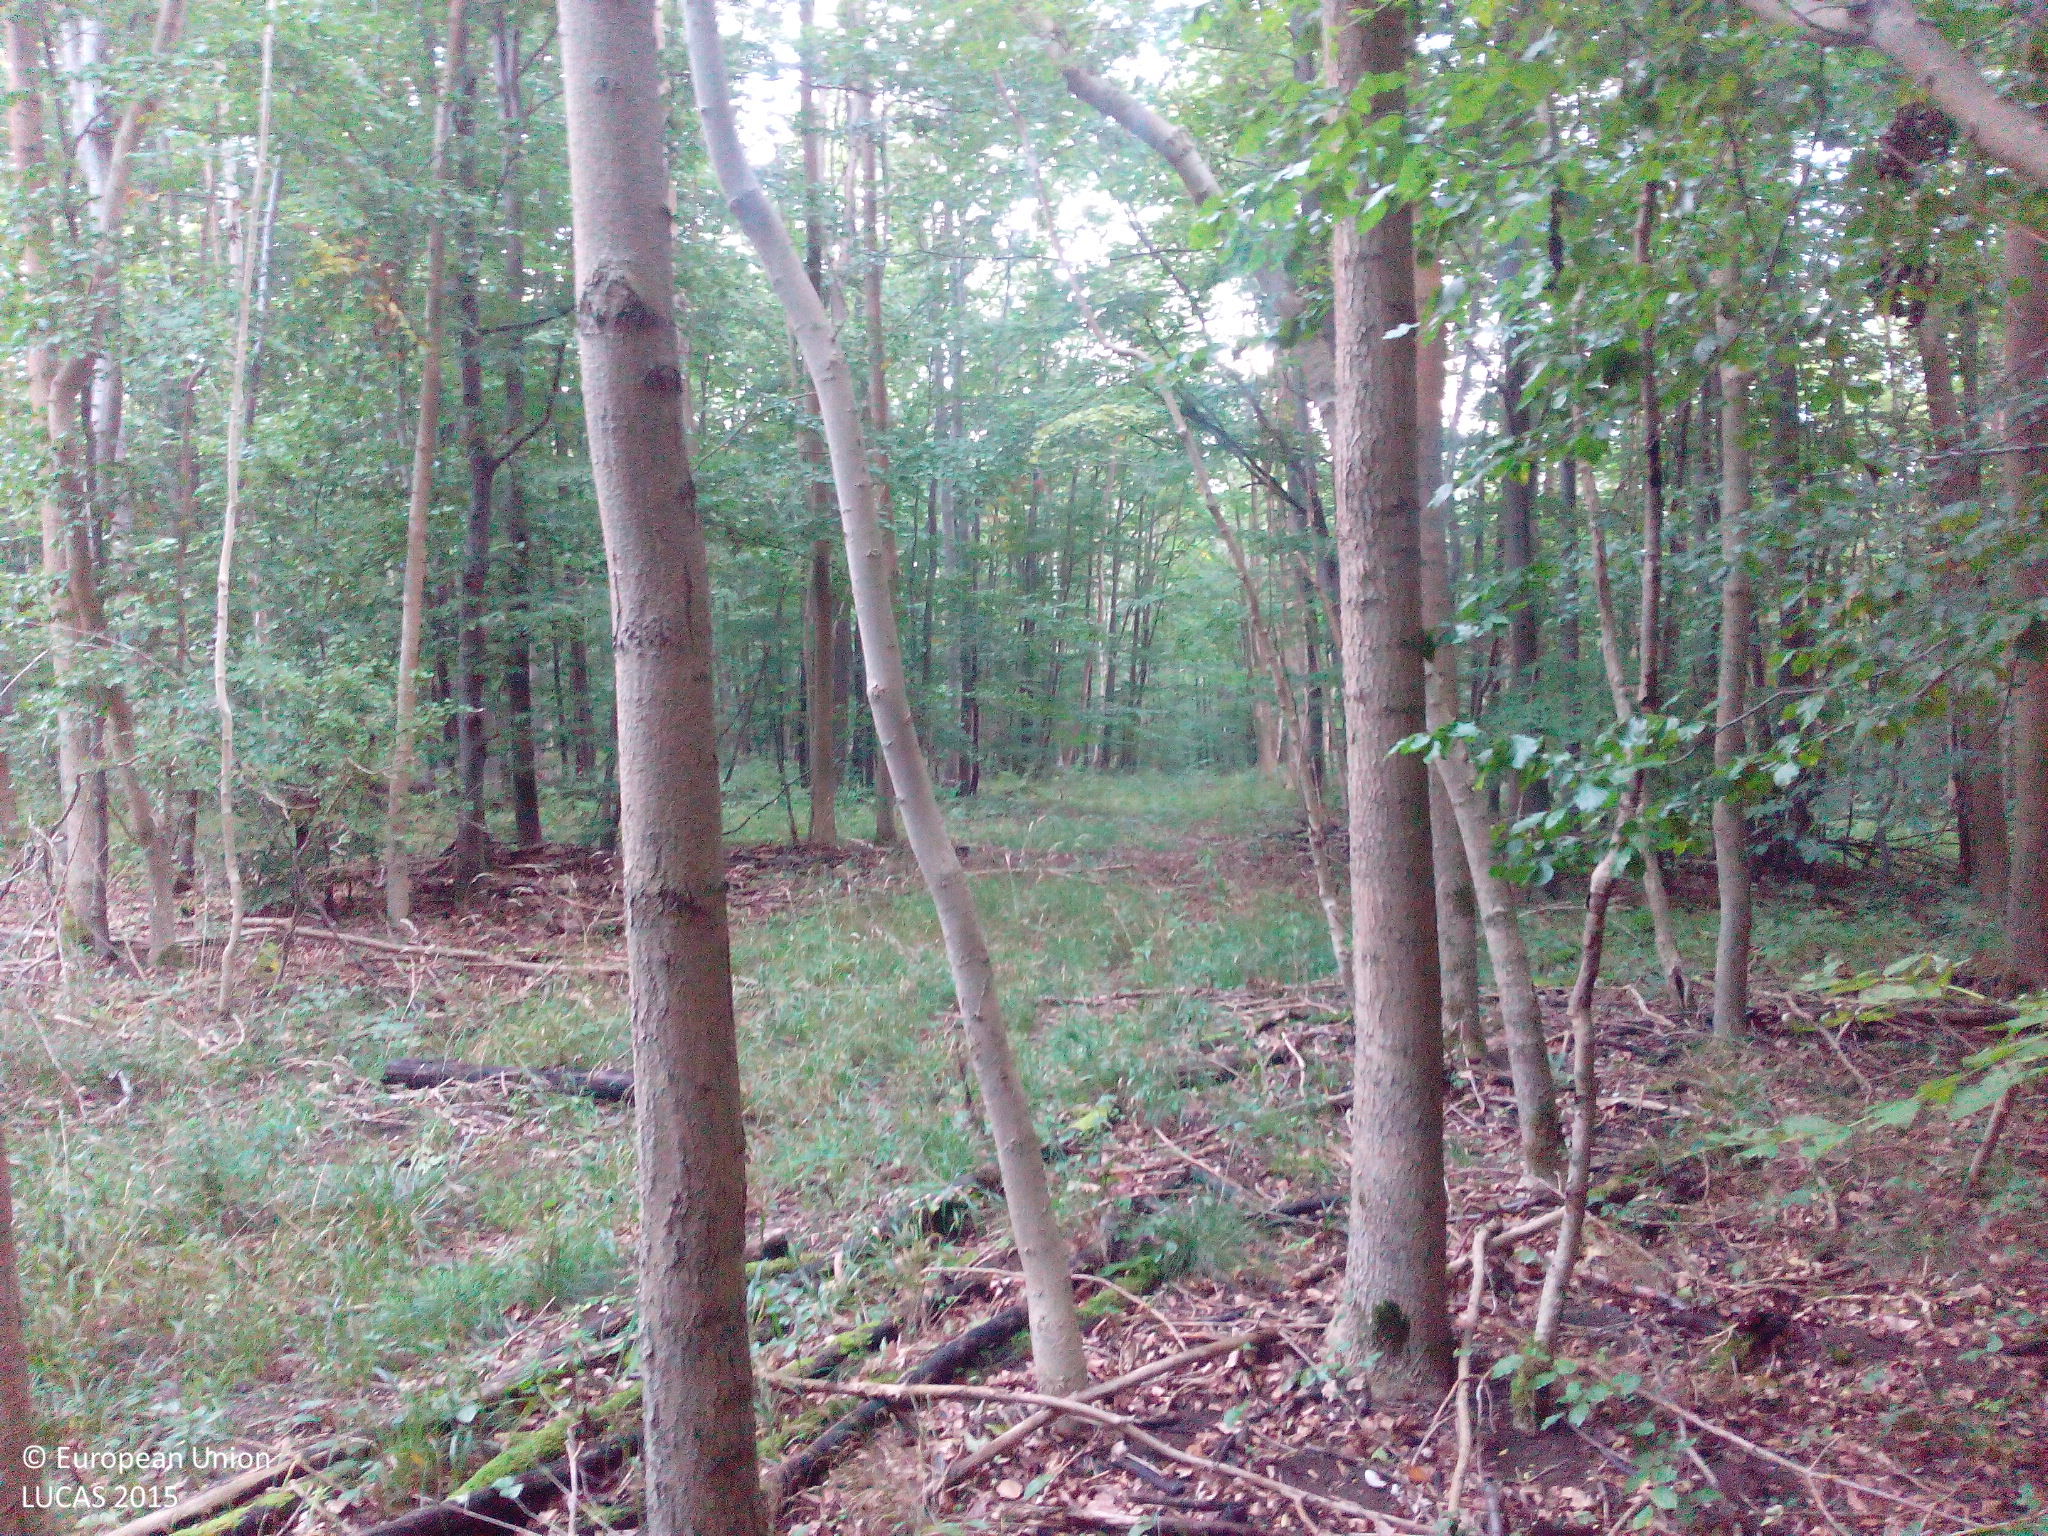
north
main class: Woodland
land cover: Broadleaved woodland
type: beech forest
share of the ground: > 75 %
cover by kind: broadleaved forest trees 100 %
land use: Forestry
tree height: > 5 m
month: September
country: DE
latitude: 51.3872
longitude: 10.6177
